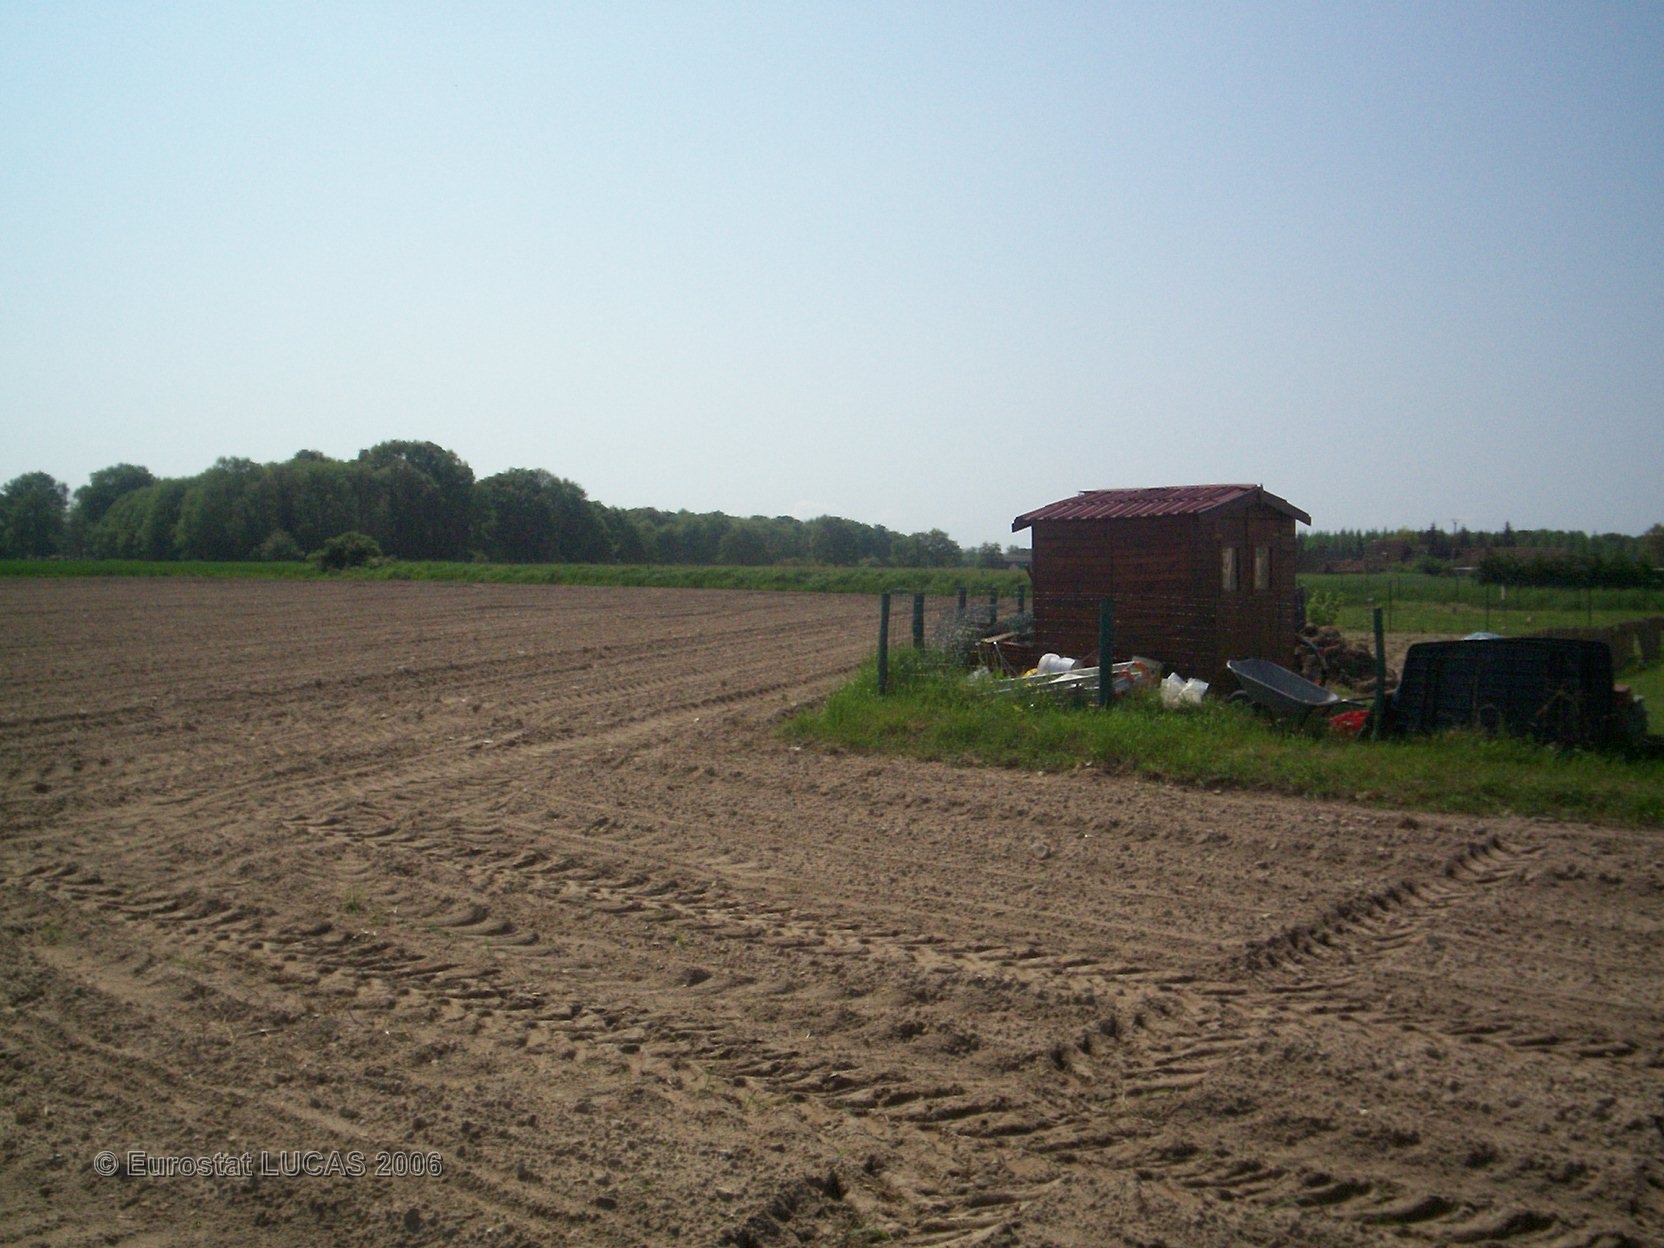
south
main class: Cropland
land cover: Maize
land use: Agriculture (excluding fallow land and kitchen gardens)
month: May
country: FR
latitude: 47.7827
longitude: 0.1645
